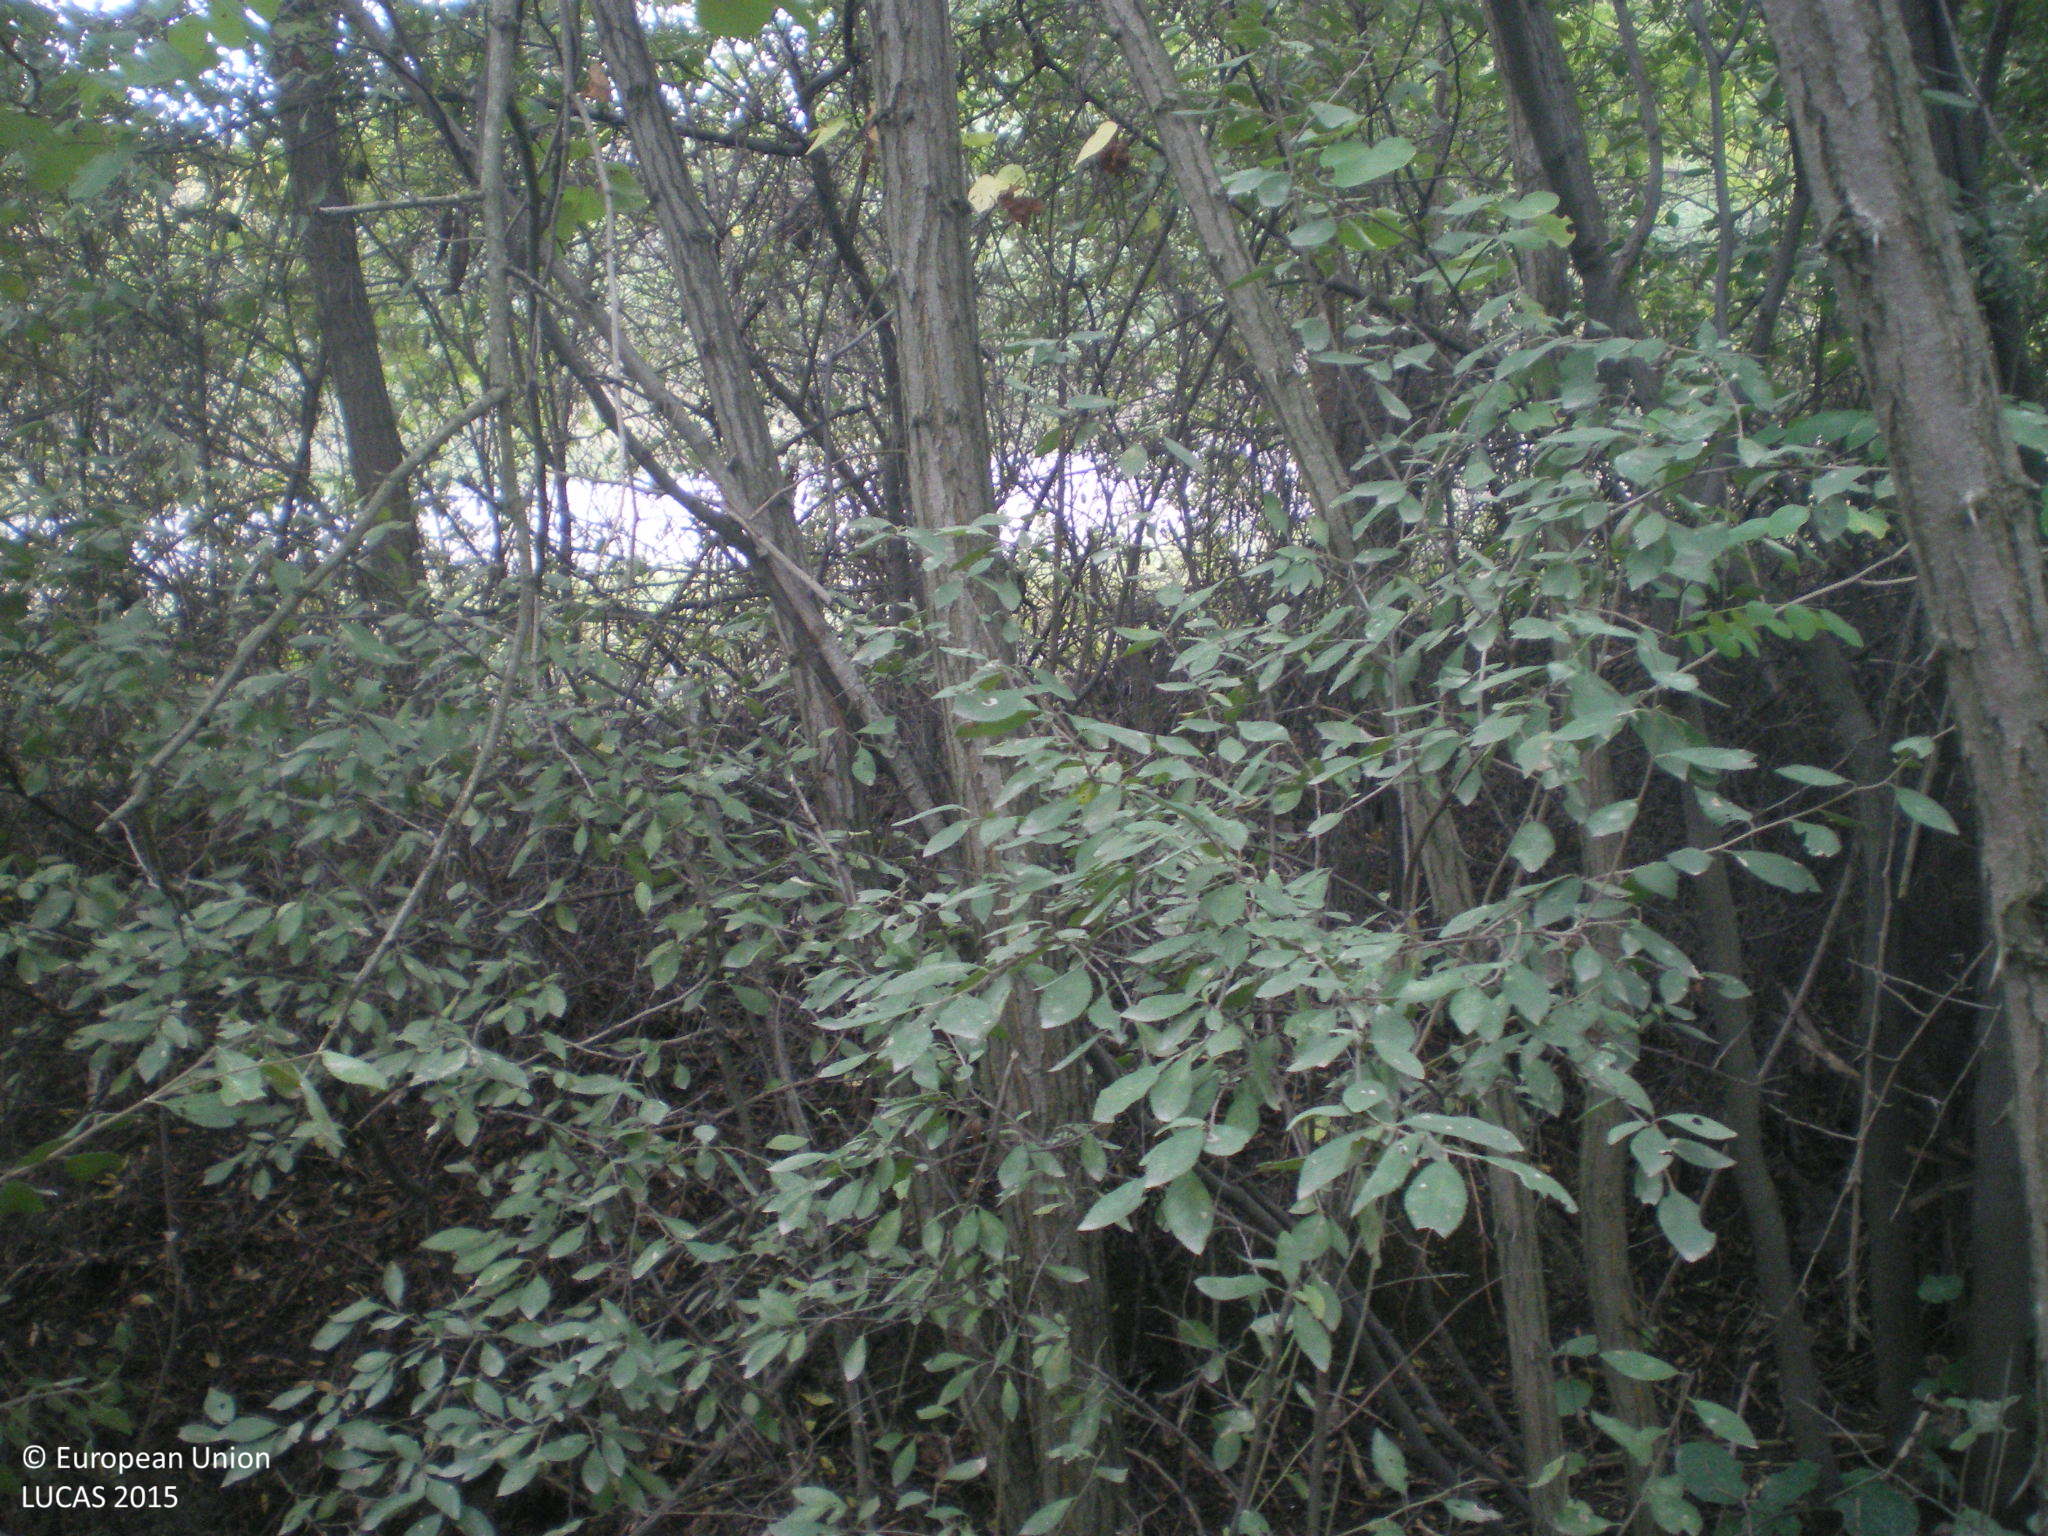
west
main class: Woodland
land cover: Broadleaved woodland
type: mesophytic deciduous forest
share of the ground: > 75 %
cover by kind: broadleaved forest trees 95 %, unconsolidated bare surface 5 %
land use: Forestry
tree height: > 5 m
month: October
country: BG
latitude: 42.1713
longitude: 25.9456
